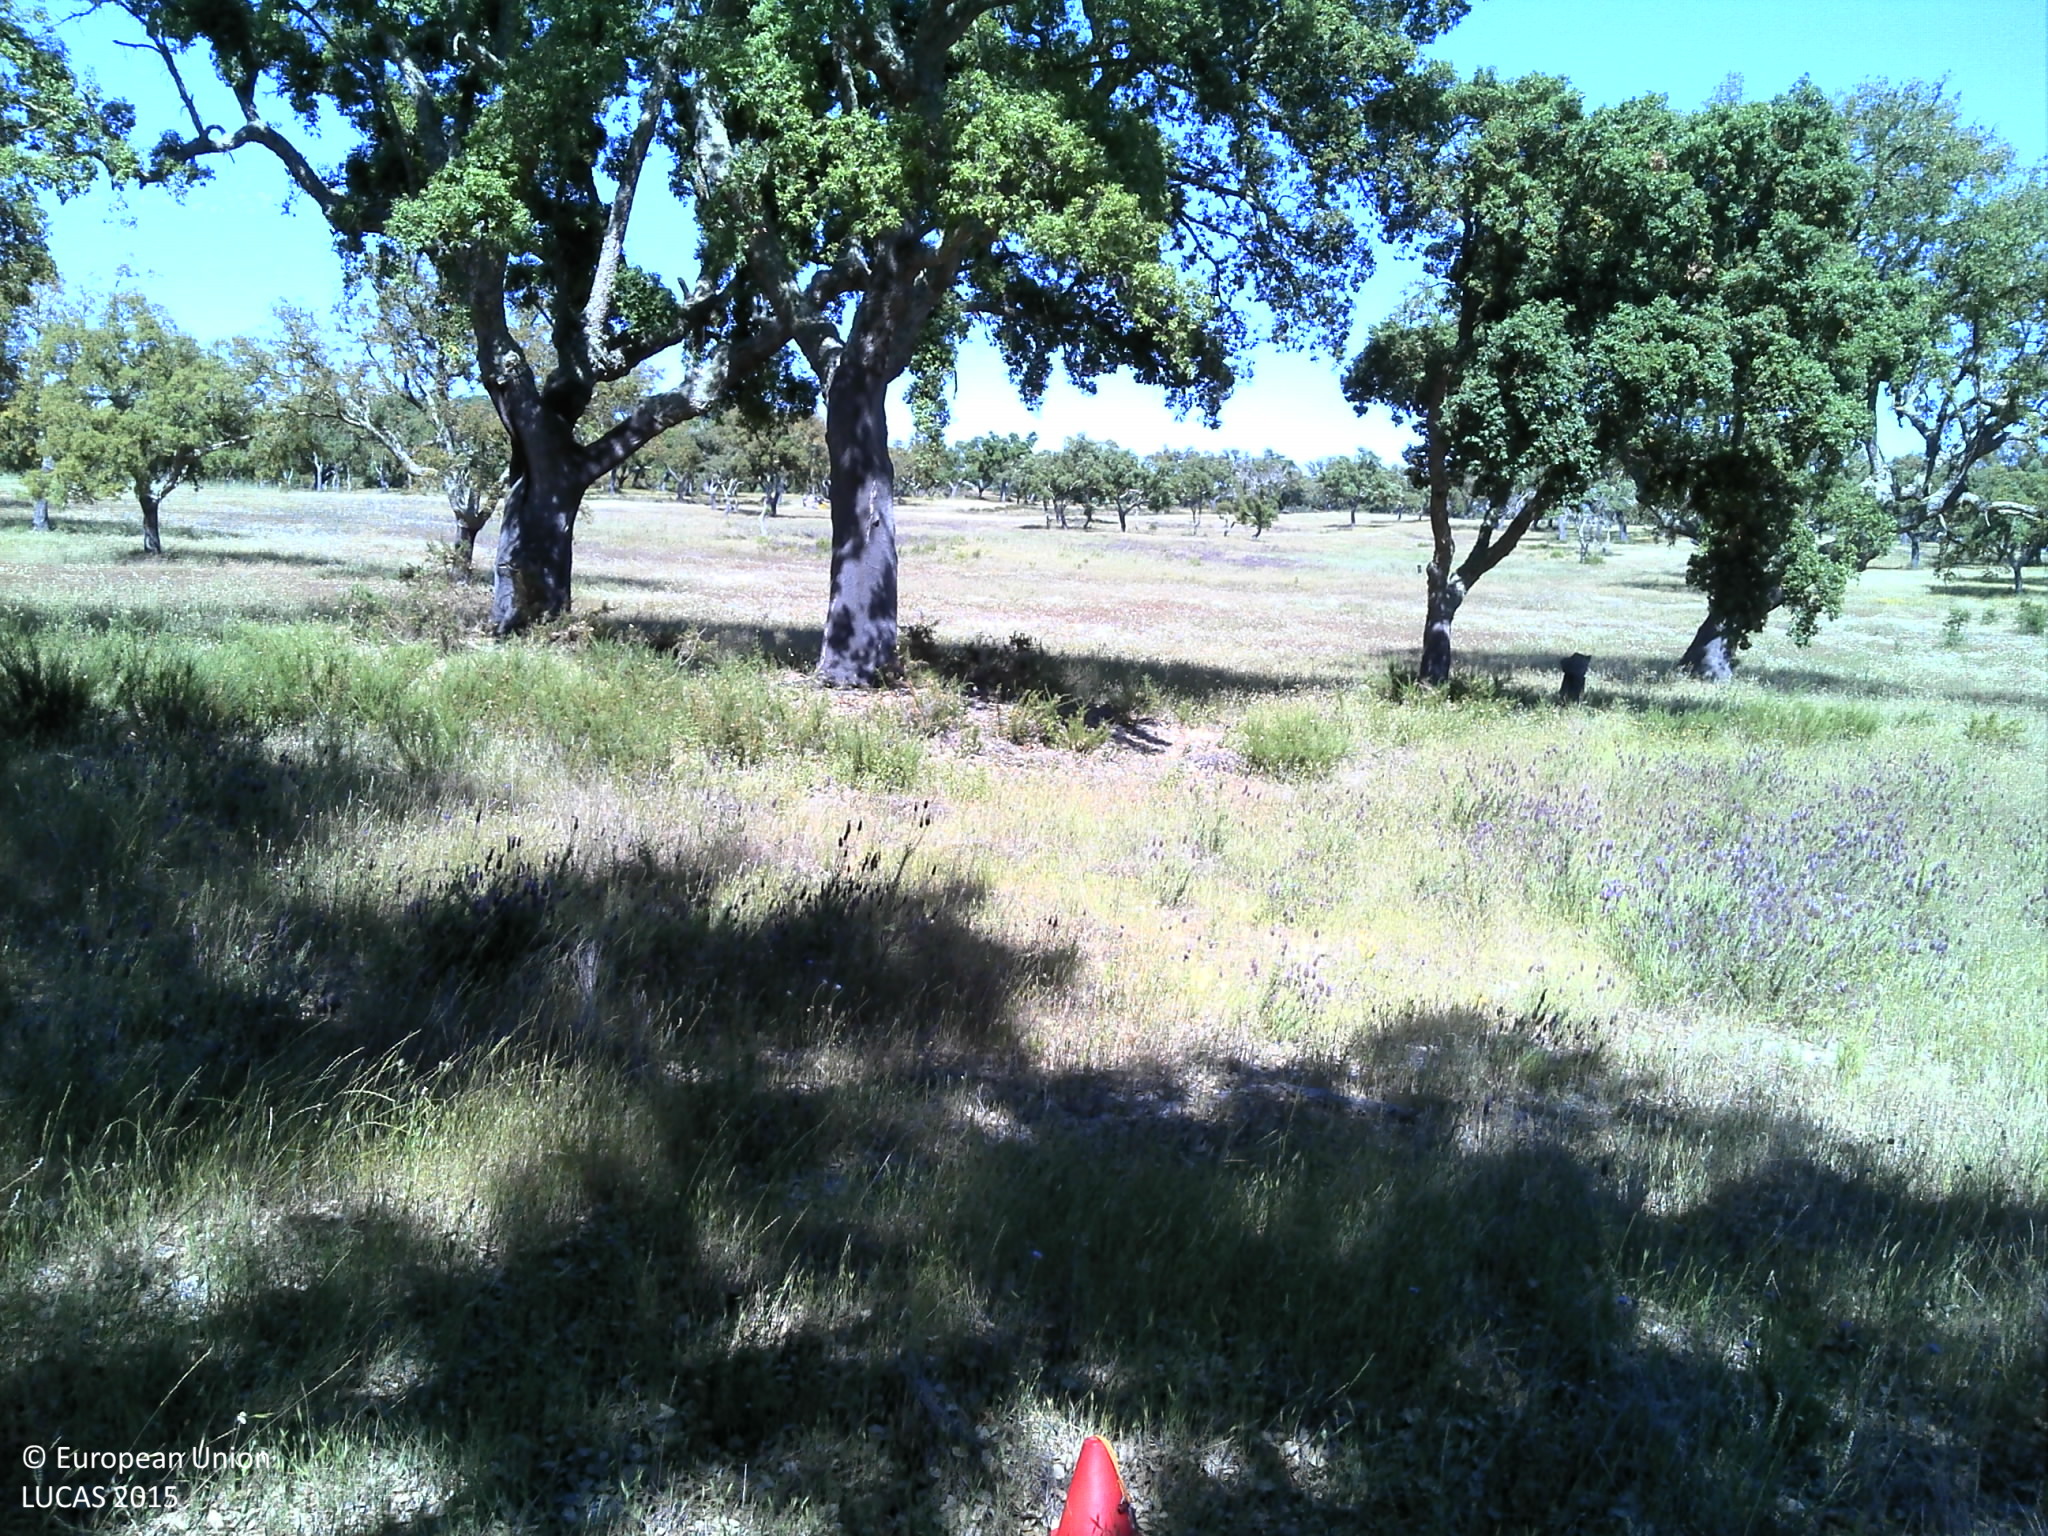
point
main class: Woodland
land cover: Broadleaved woodland
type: broadleaved evergreen forest
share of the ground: 25 - 50 %
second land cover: Grassland without tree/shrub cover
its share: 50 - 75 %
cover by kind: herbaceous plants 60 %, broadleaved forest trees 30 %, unconsolidated bare surface 10 %
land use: Forestry
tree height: > 5 m
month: May
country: PT
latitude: 39.1414
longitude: -7.9022
